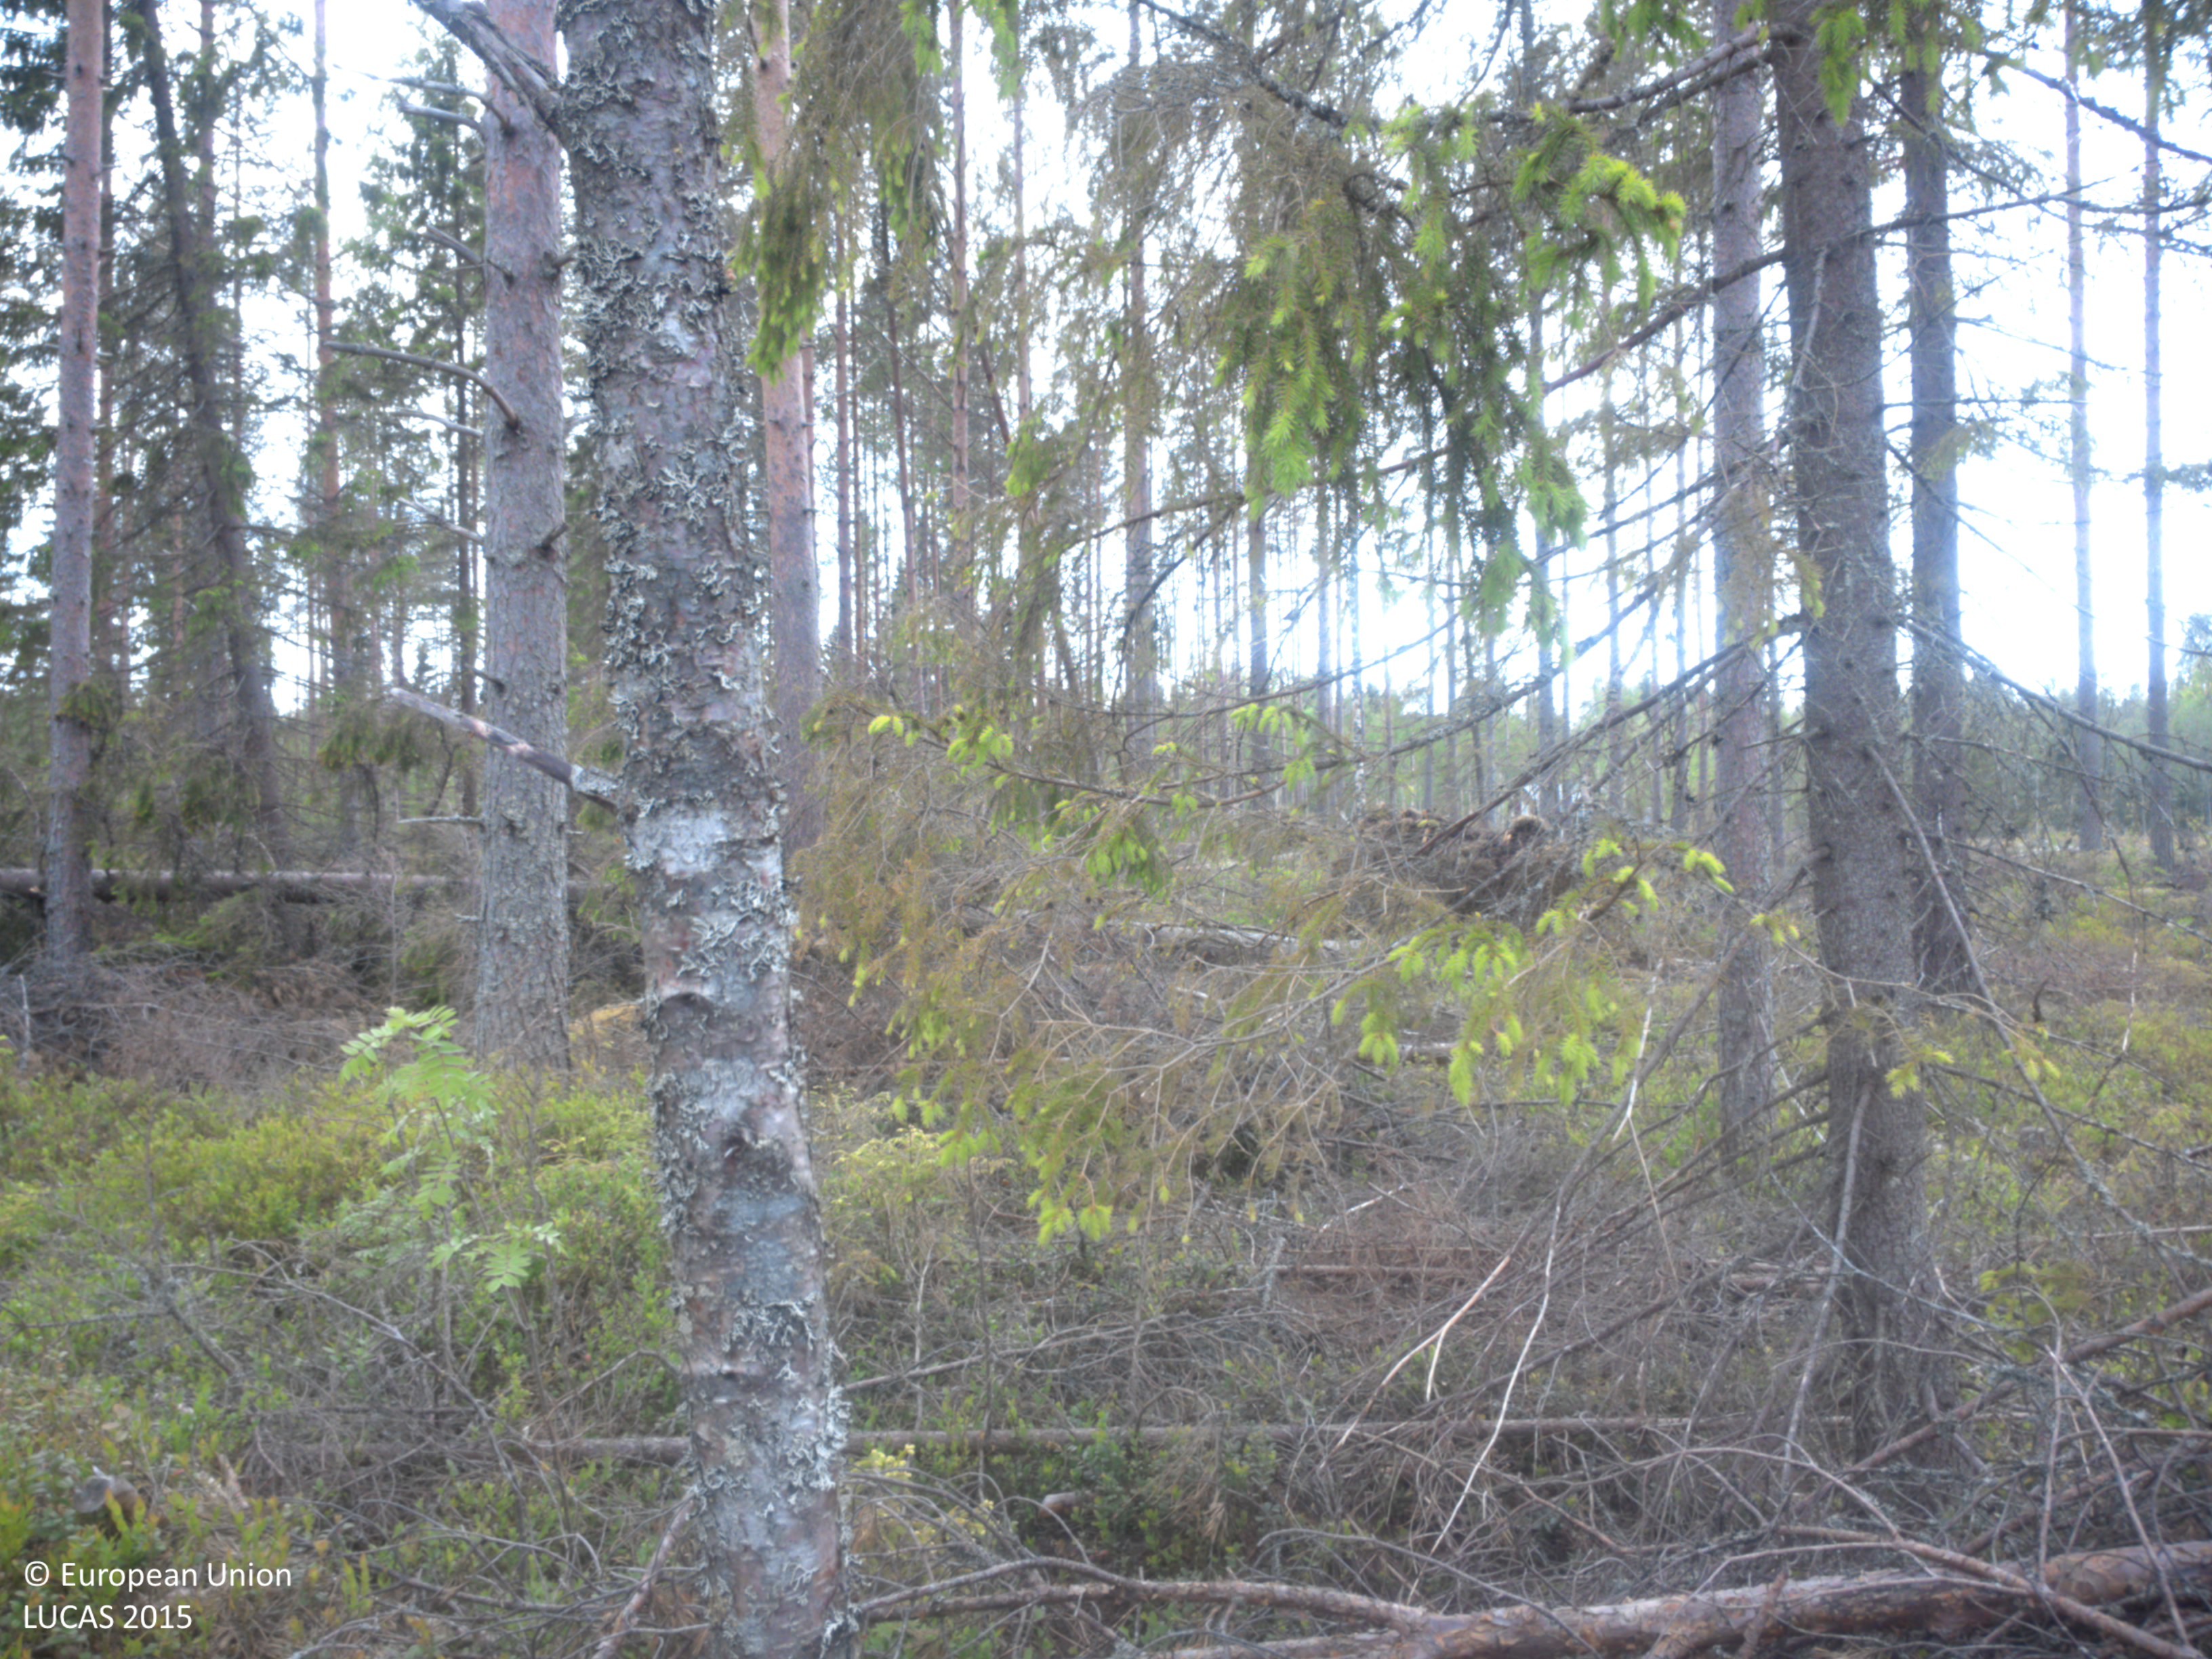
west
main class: Woodland
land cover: Pine dominated coniferous woodland
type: boreal forest
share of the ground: 25 - 50 %
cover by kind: herbaceous plants 30 %, coniferous forest trees 25 %, shrubs 20 %, lichens and mosses 15 %, unconsolidated bare surface 10 %
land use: Forestry
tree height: > 5 m
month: June
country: SE
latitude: 63.5824
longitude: 19.8326
